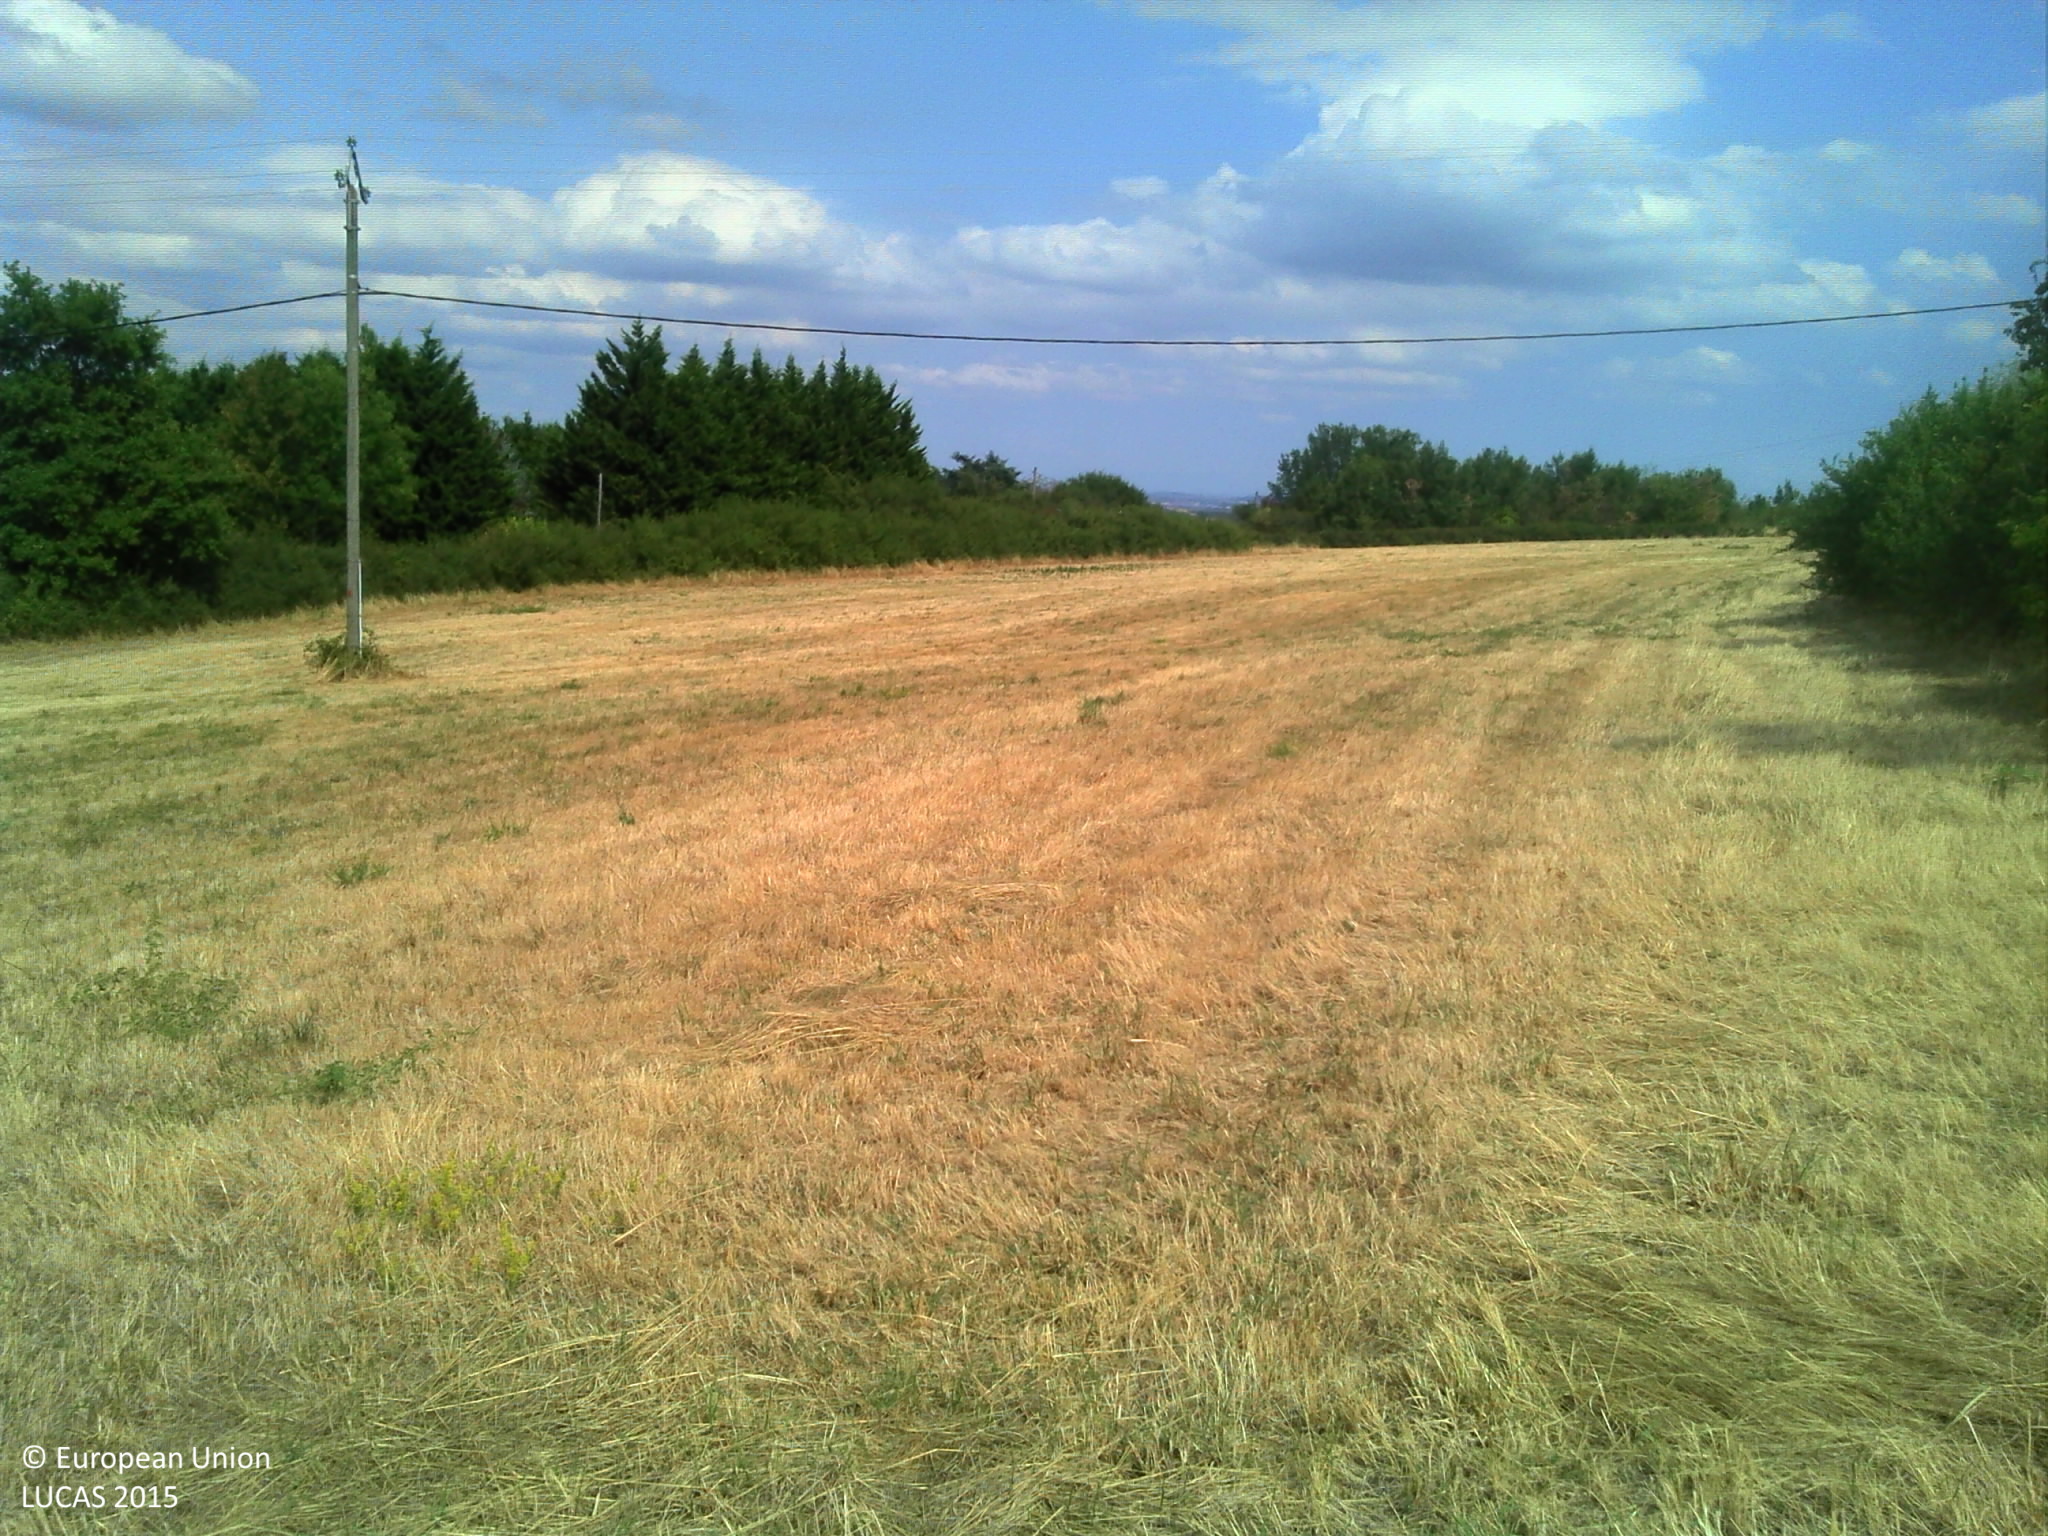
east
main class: Grassland
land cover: Grassland without tree/shrub cover
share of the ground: > 75 %
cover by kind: herbaceous plants 100 %
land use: Agriculture (excluding fallow land and kitchen gardens)
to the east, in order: Grassland without tree/shrub cover; Electric lines; Grassland without tree/shrub cover; Abandoned hedges; Fences; Electric lines; Ditches and canals; Grass margins; Paved roads, cycling and walking lanes; Grass margins; Common wheat; Abandoned hedges; Common wheat; Other fruit trees and berries
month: August
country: FR
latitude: 45.6604
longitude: 4.7031
